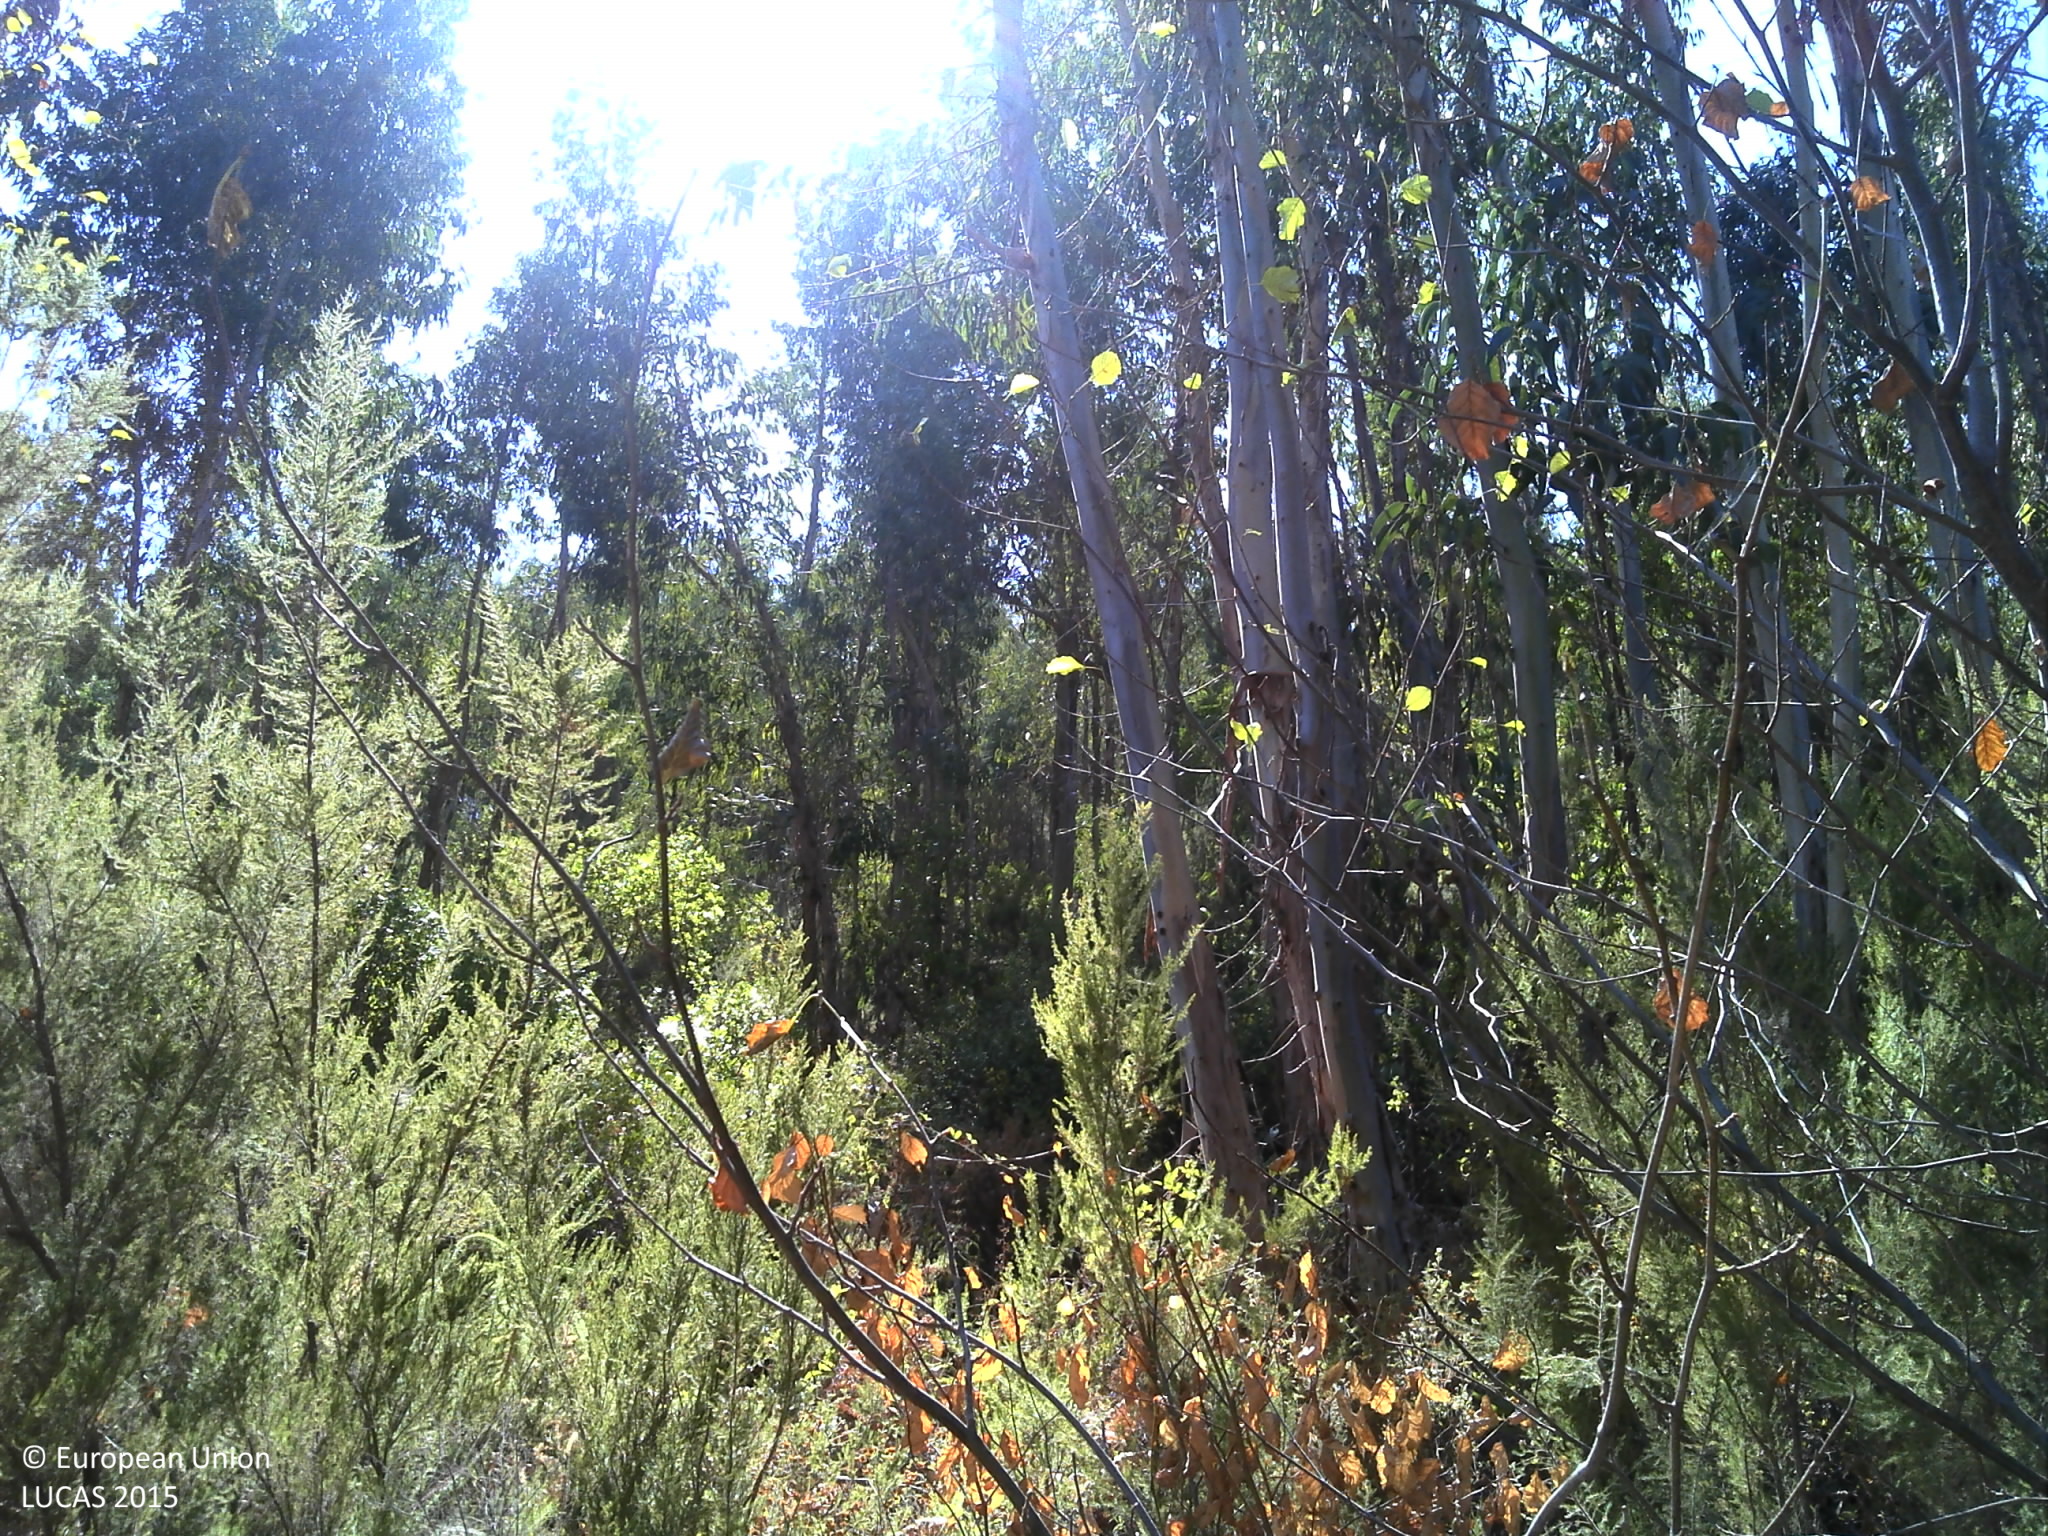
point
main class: Woodland
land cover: Broadleaved woodland
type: exotic forest
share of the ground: 50 - 75 %
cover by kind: broadleaved forest trees 70 %, unconsolidated bare surface 20 %, shrubs 10 %
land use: Forestry
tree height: > 5 m
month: September
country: PT
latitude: 37.3541
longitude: -8.4411
